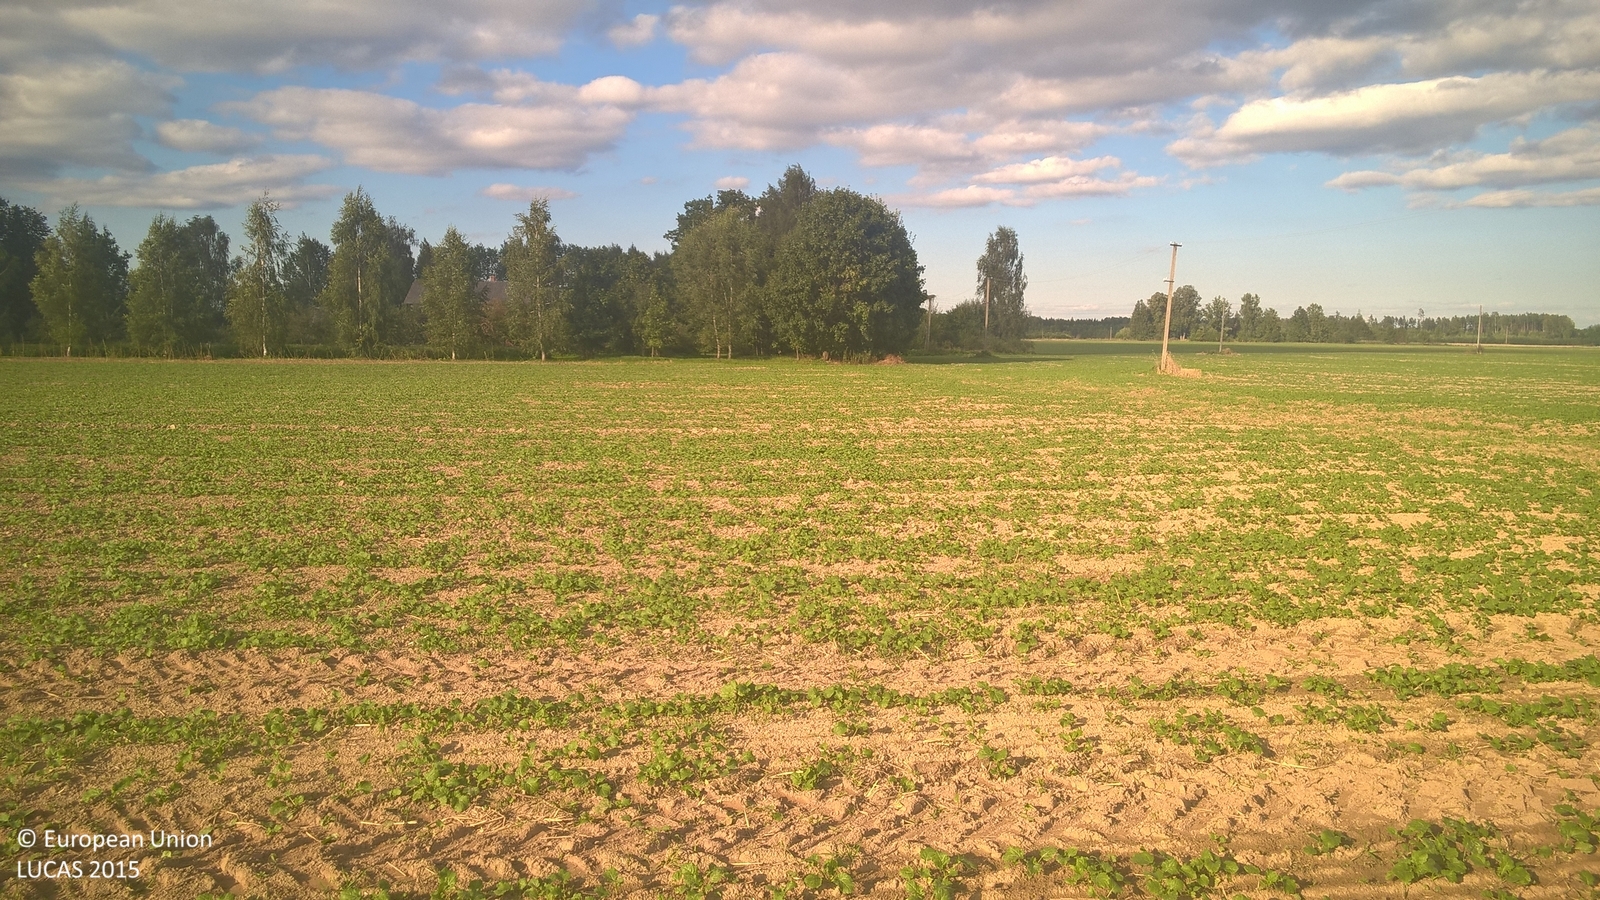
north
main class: Cropland
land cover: Rape and turnip rape
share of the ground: 25 - 50 %
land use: Agriculture (excluding fallow land and kitchen gardens)
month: September
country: LV
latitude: 57.4472
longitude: 25.5980
